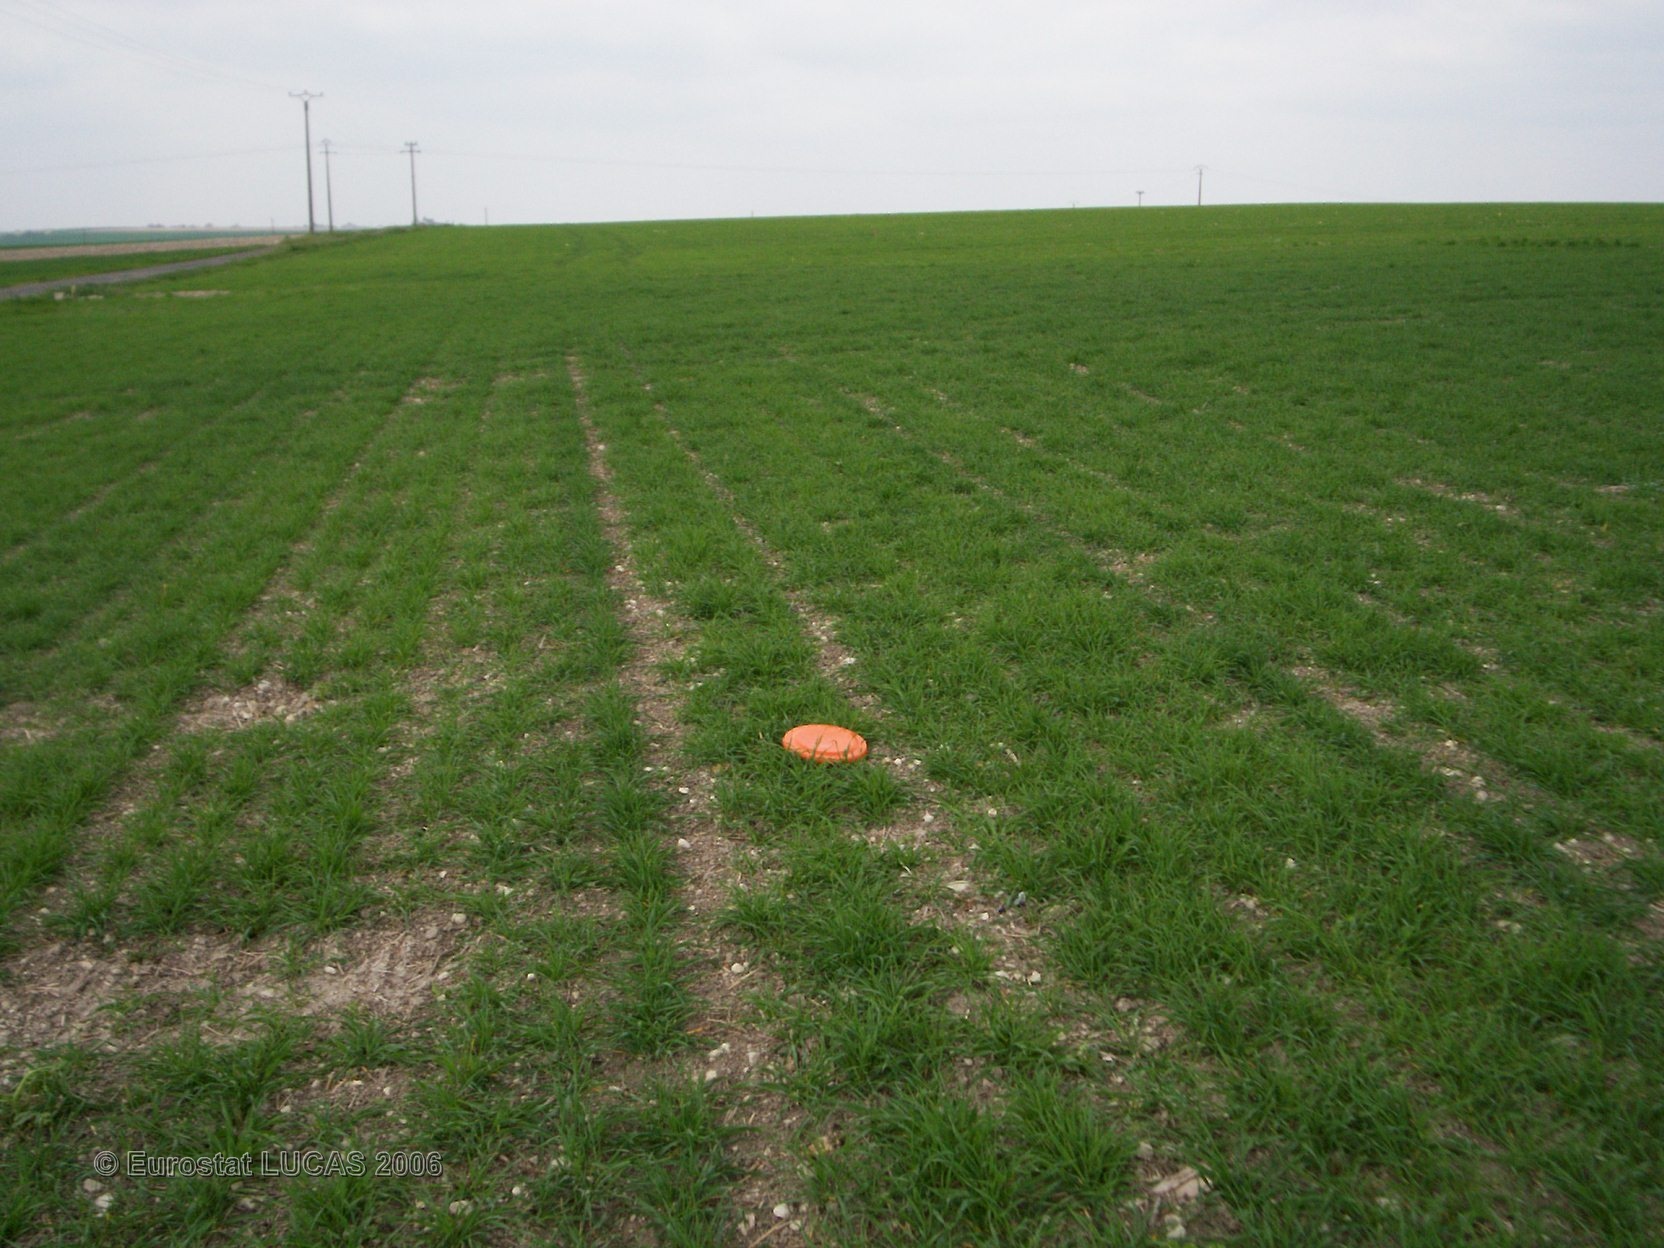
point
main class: Cropland
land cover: Barley
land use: Agriculture (excluding fallow land and kitchen gardens)
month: April
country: FR
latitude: 47.0900
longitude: 0.3227
